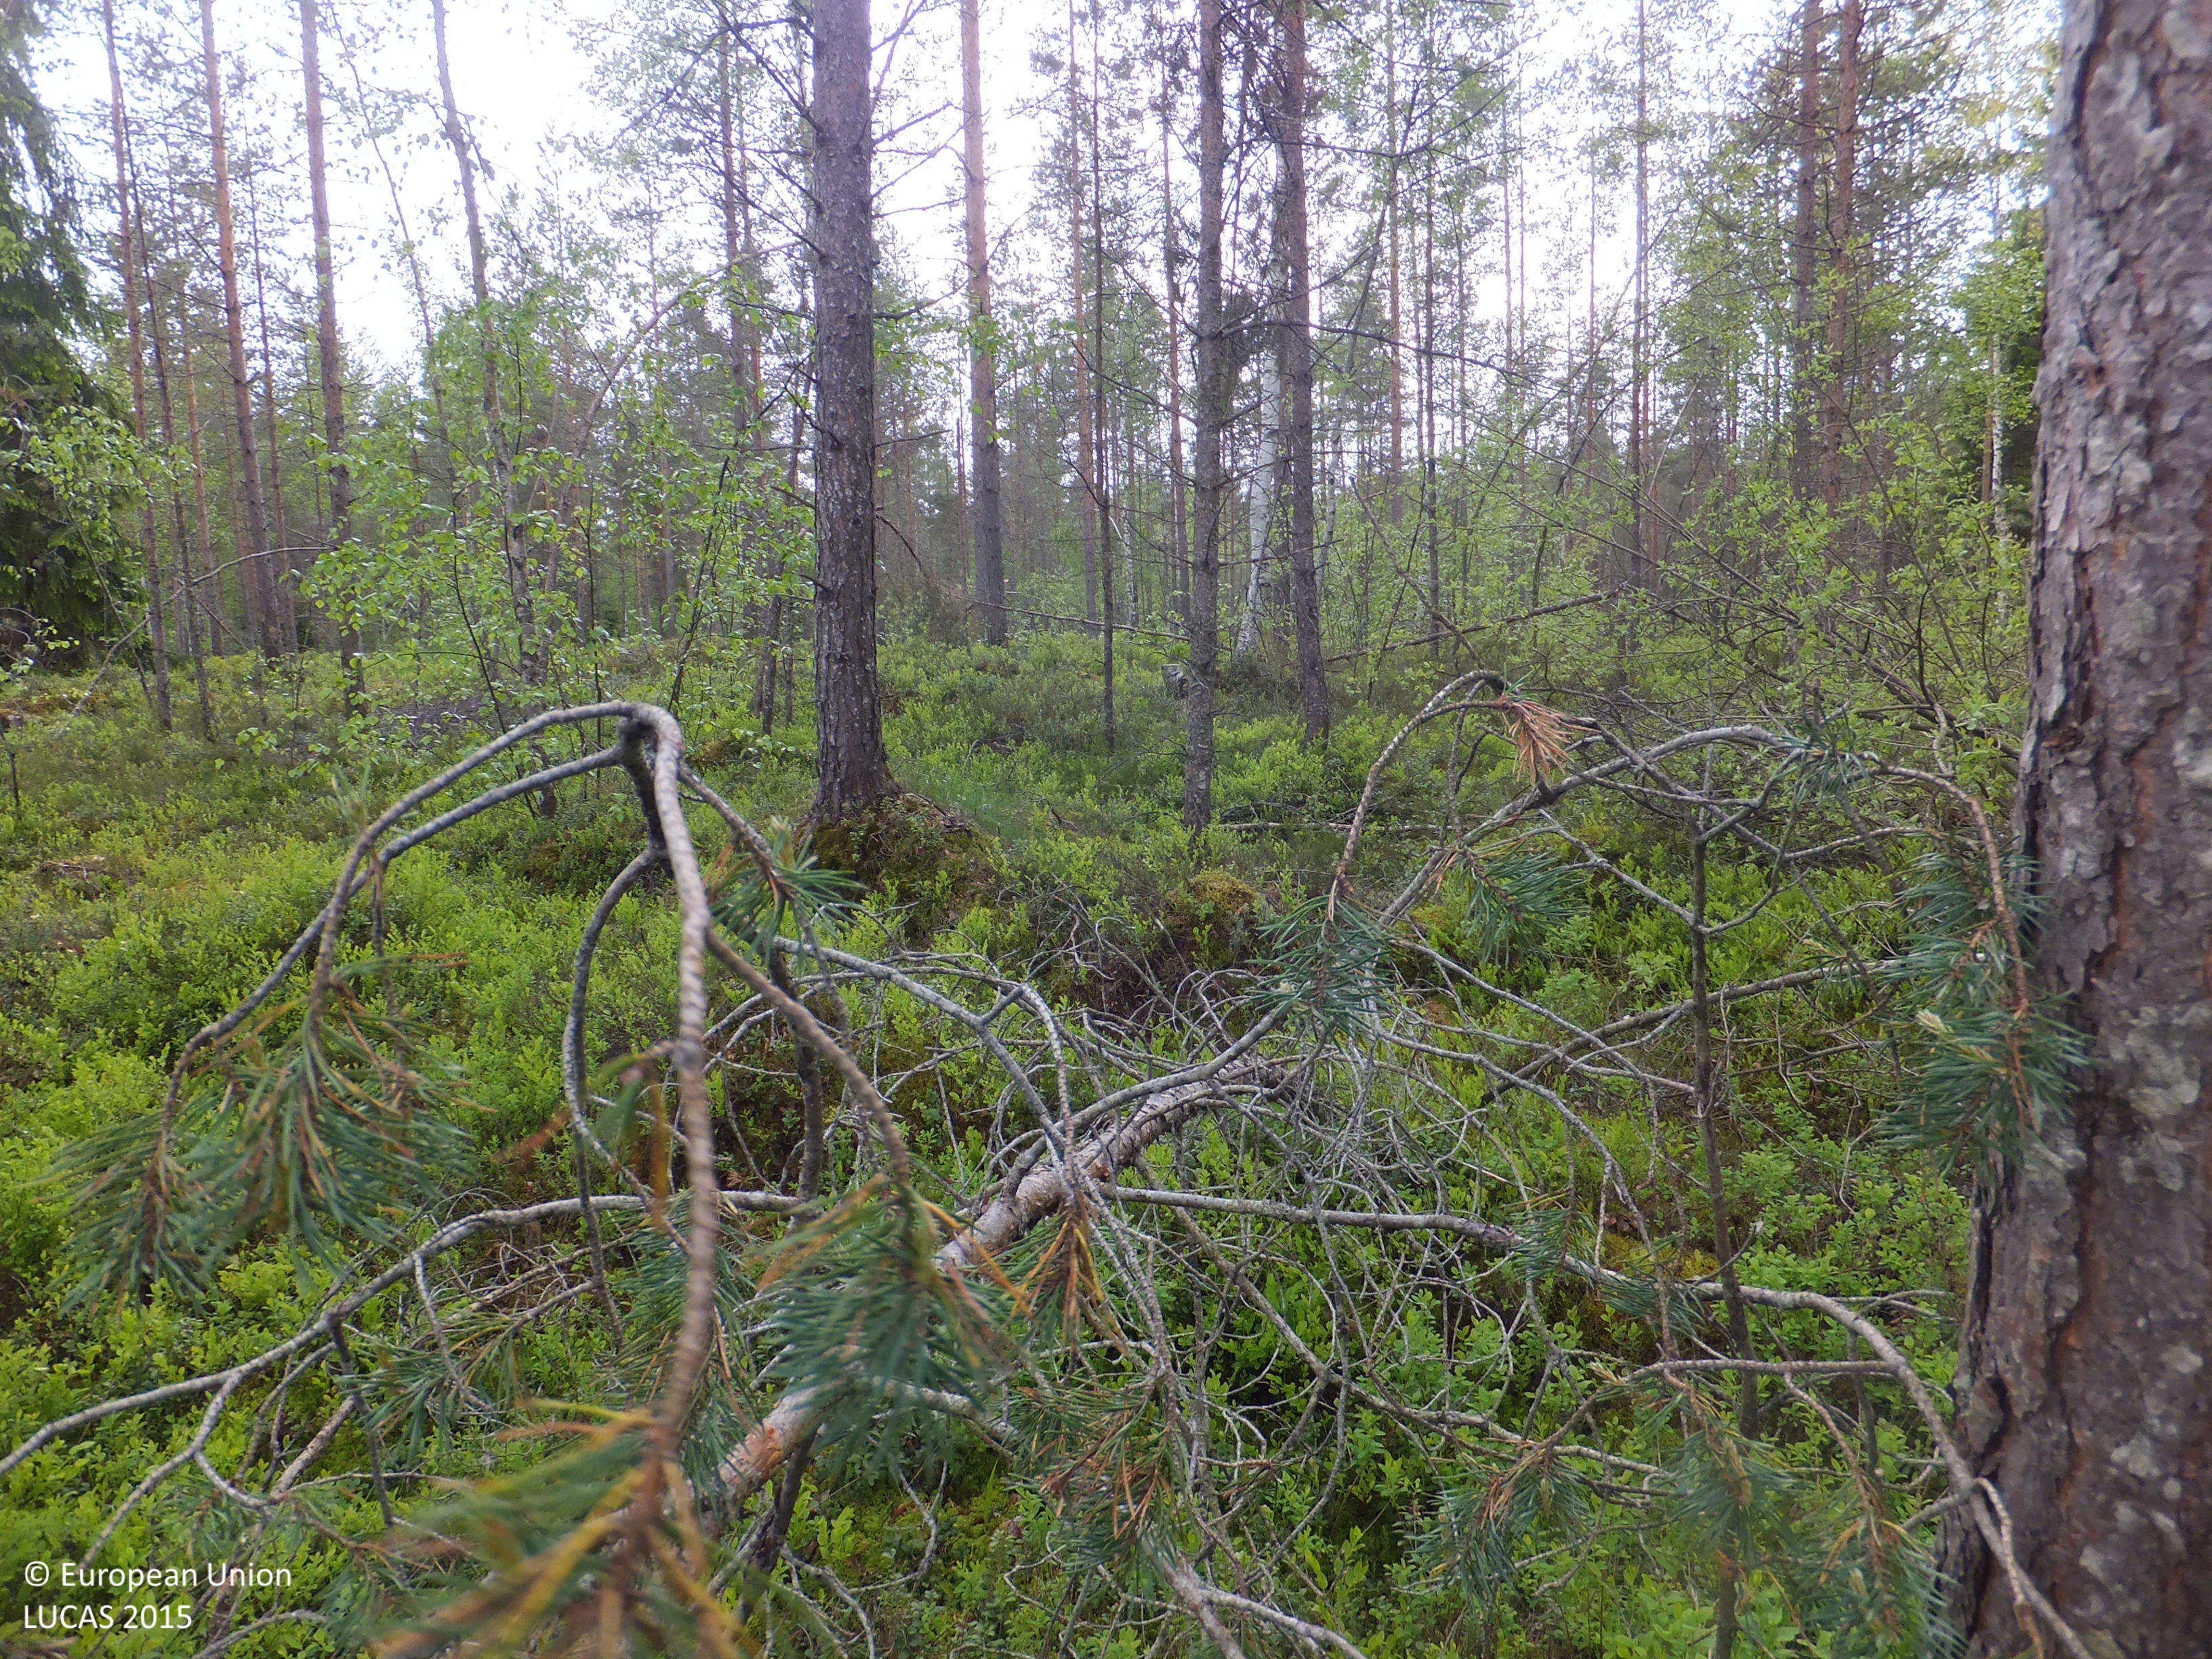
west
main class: Woodland
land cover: Pine dominated mixed woodland
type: boreal forest
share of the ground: 50 - 75 %
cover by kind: coniferous forest trees 35 %, shrubs 35 %, broadleaved forest trees 30 %
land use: Forestry
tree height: > 5 m
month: June
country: FI
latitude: 63.5797
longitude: 23.9069
